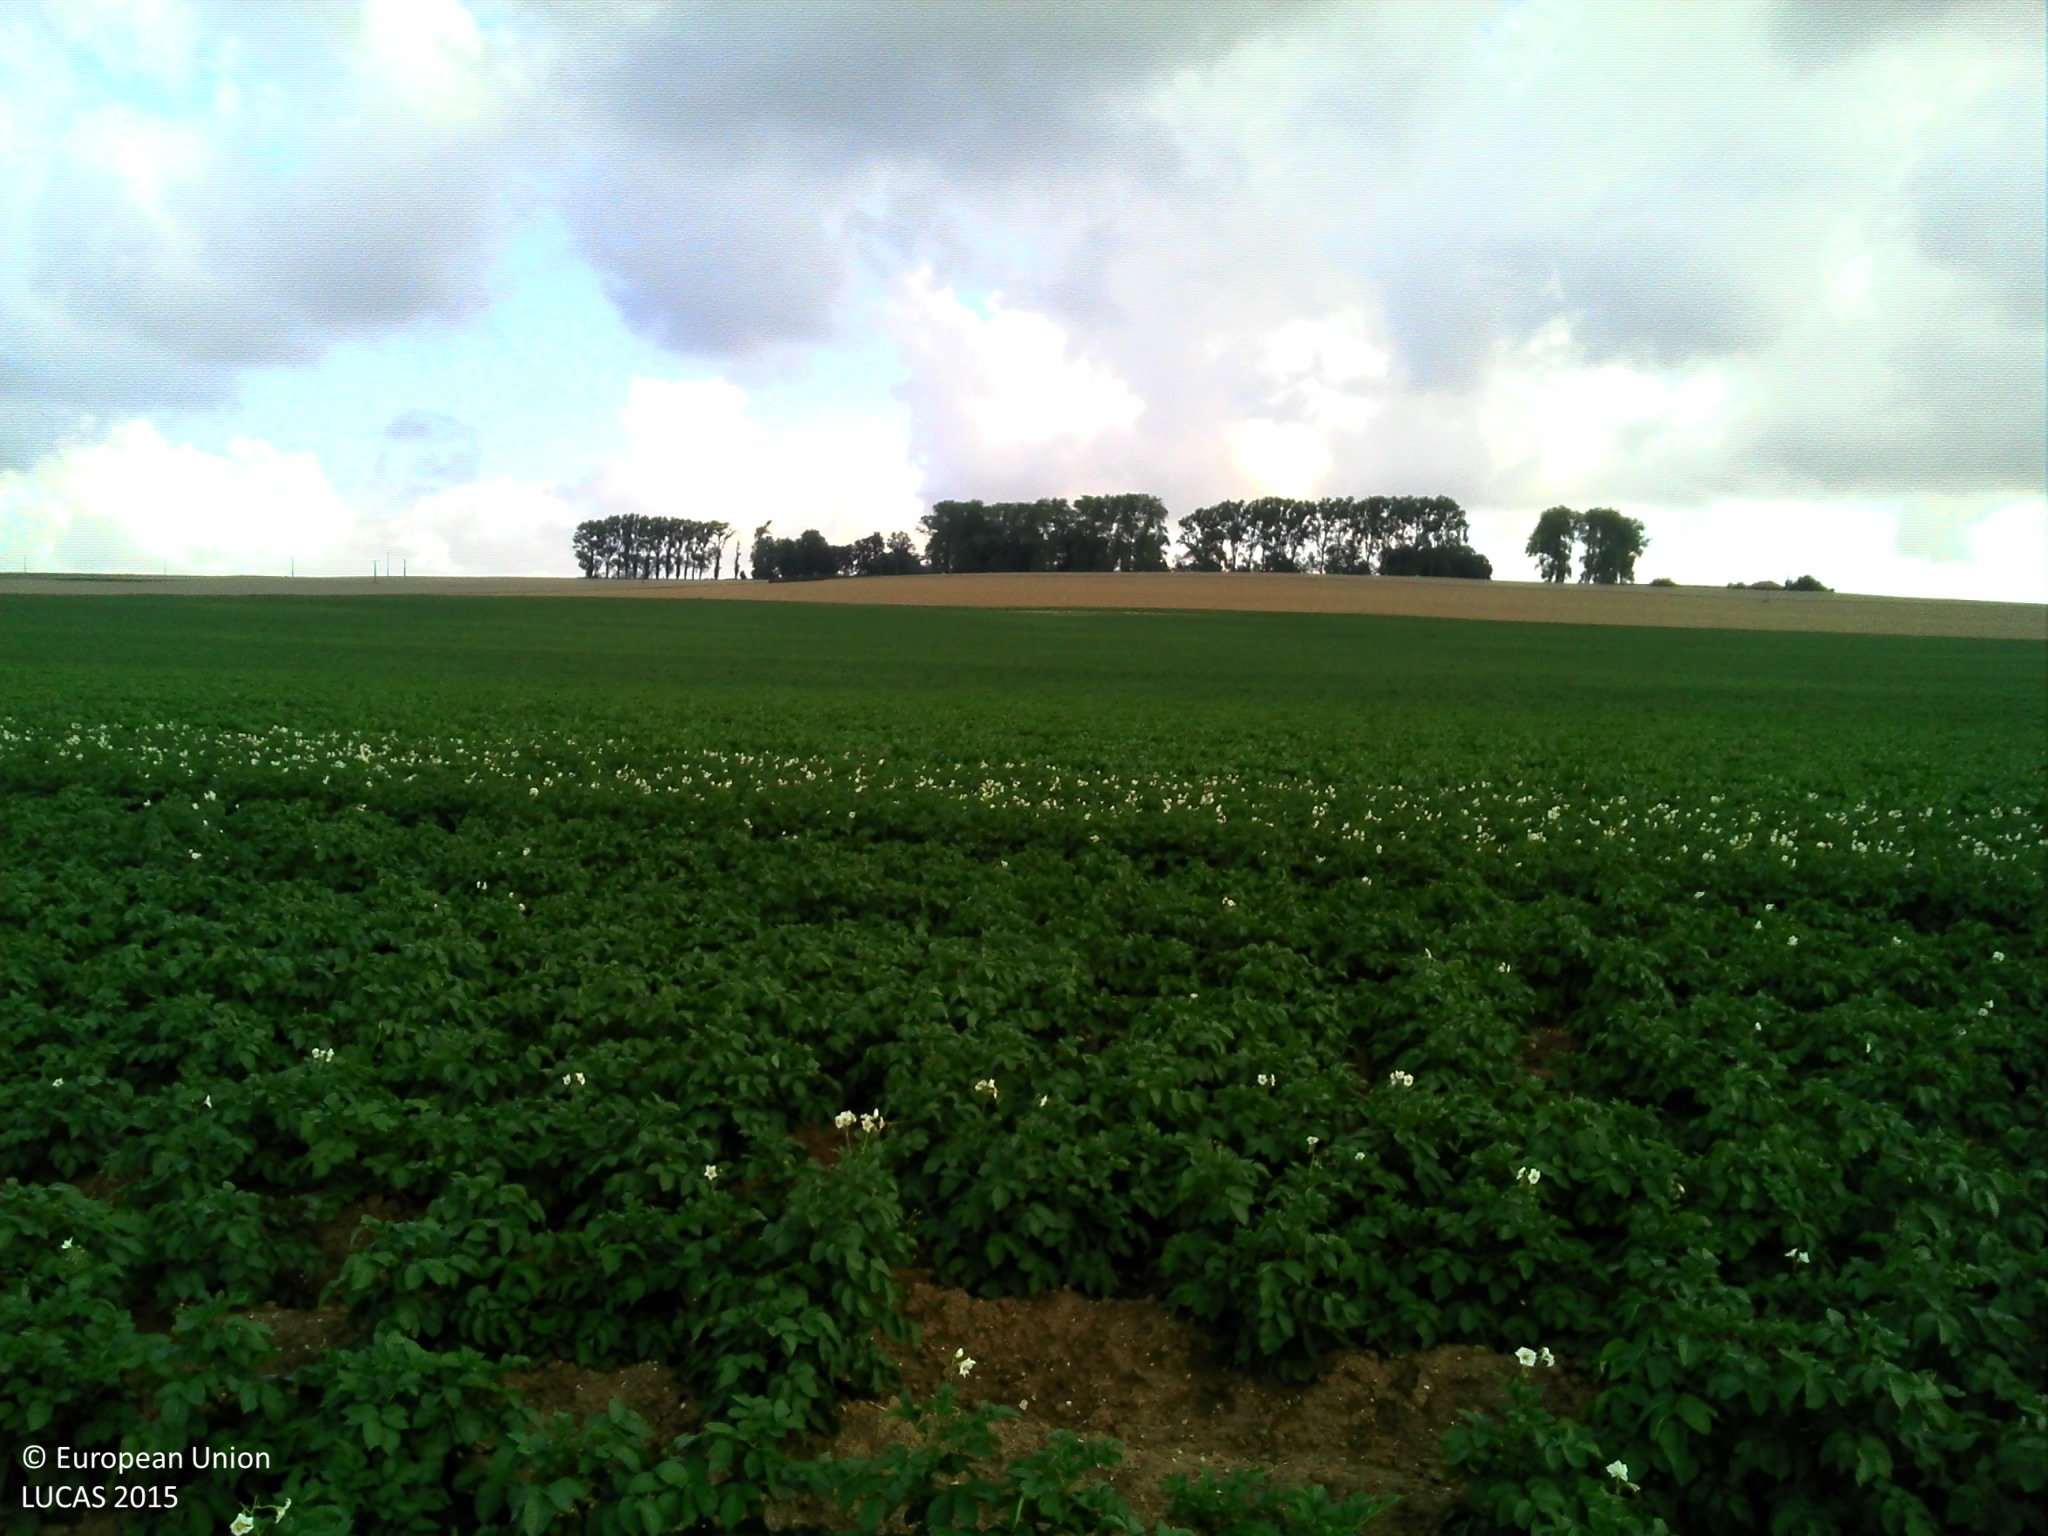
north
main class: Cropland
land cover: Potatoes
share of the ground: > 75 %
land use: Agriculture (excluding fallow land and kitchen gardens)
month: July
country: FR
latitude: 50.0410
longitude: 2.4332
